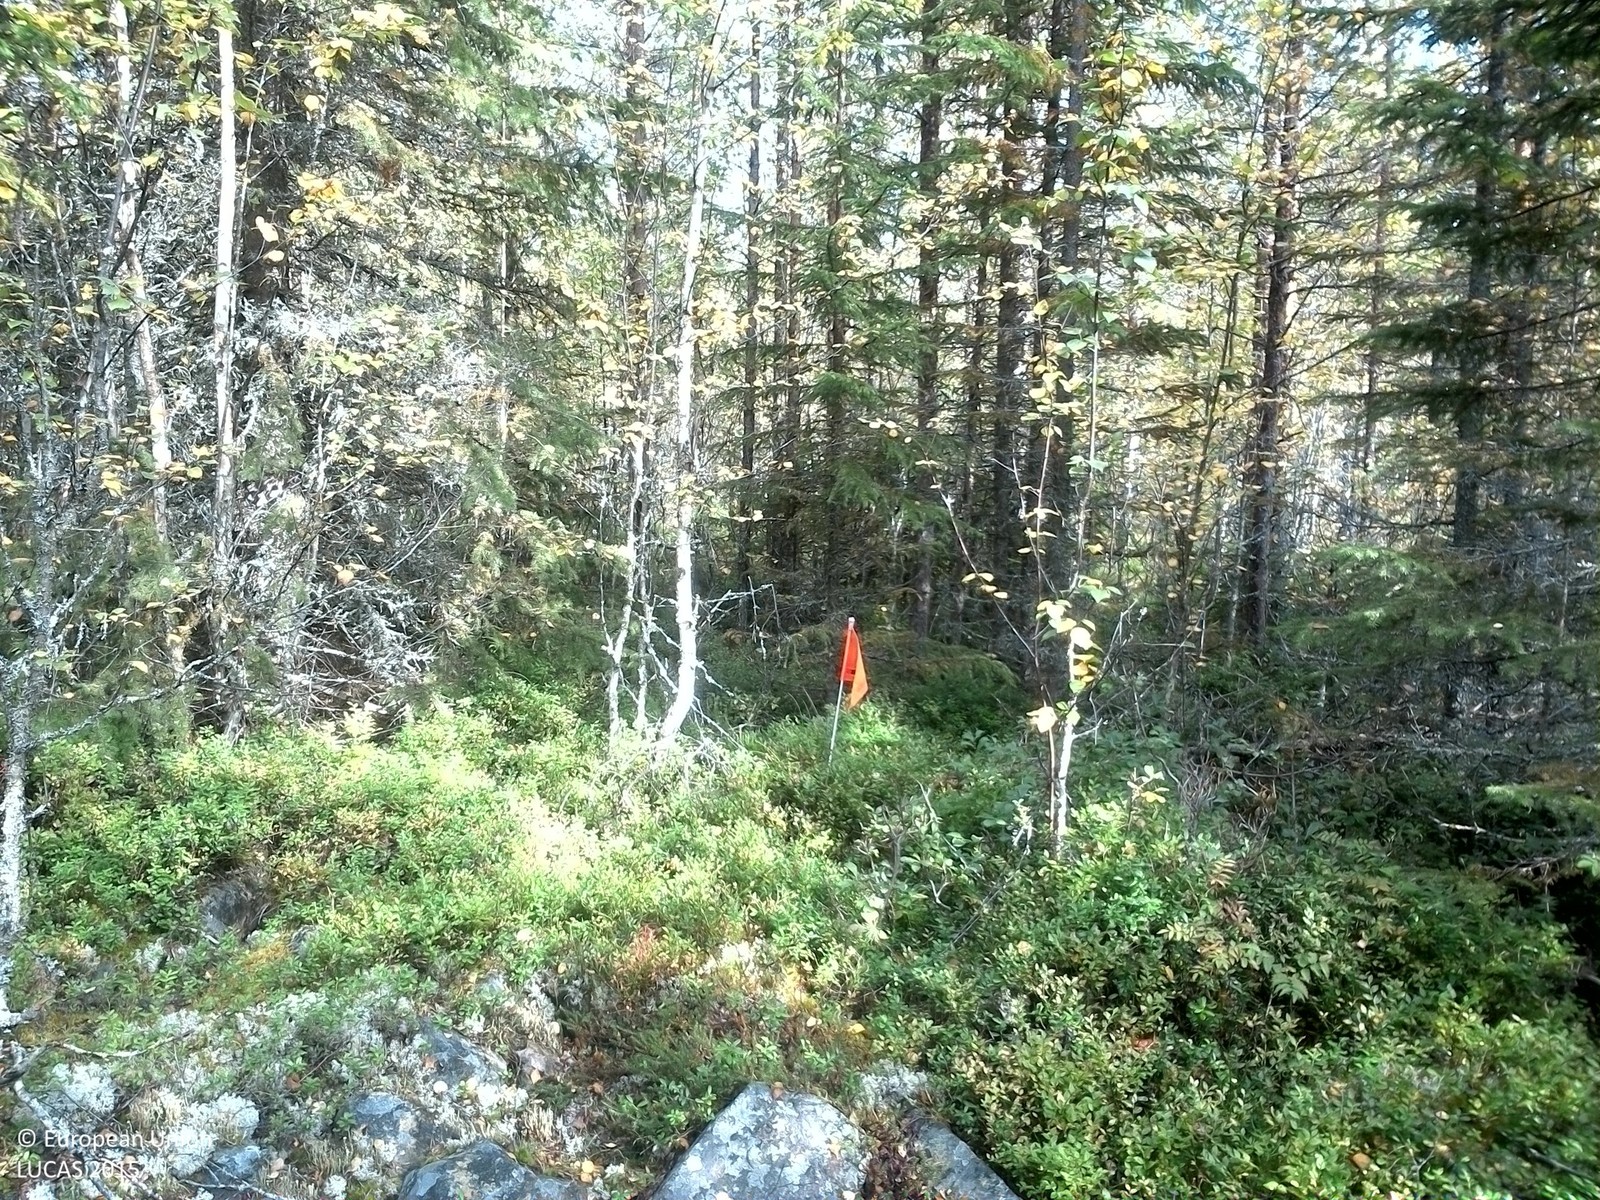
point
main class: Woodland
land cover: Other mixed woodland
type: boreal forest
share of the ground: > 75 %
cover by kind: coniferous forest trees 40 %, broadleaved forest trees 35 %, shrubs 20 %, consolidated bare surface 5 %
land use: Forestry
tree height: > 5 m
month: September
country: SE
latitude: 61.6576
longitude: 15.1385
